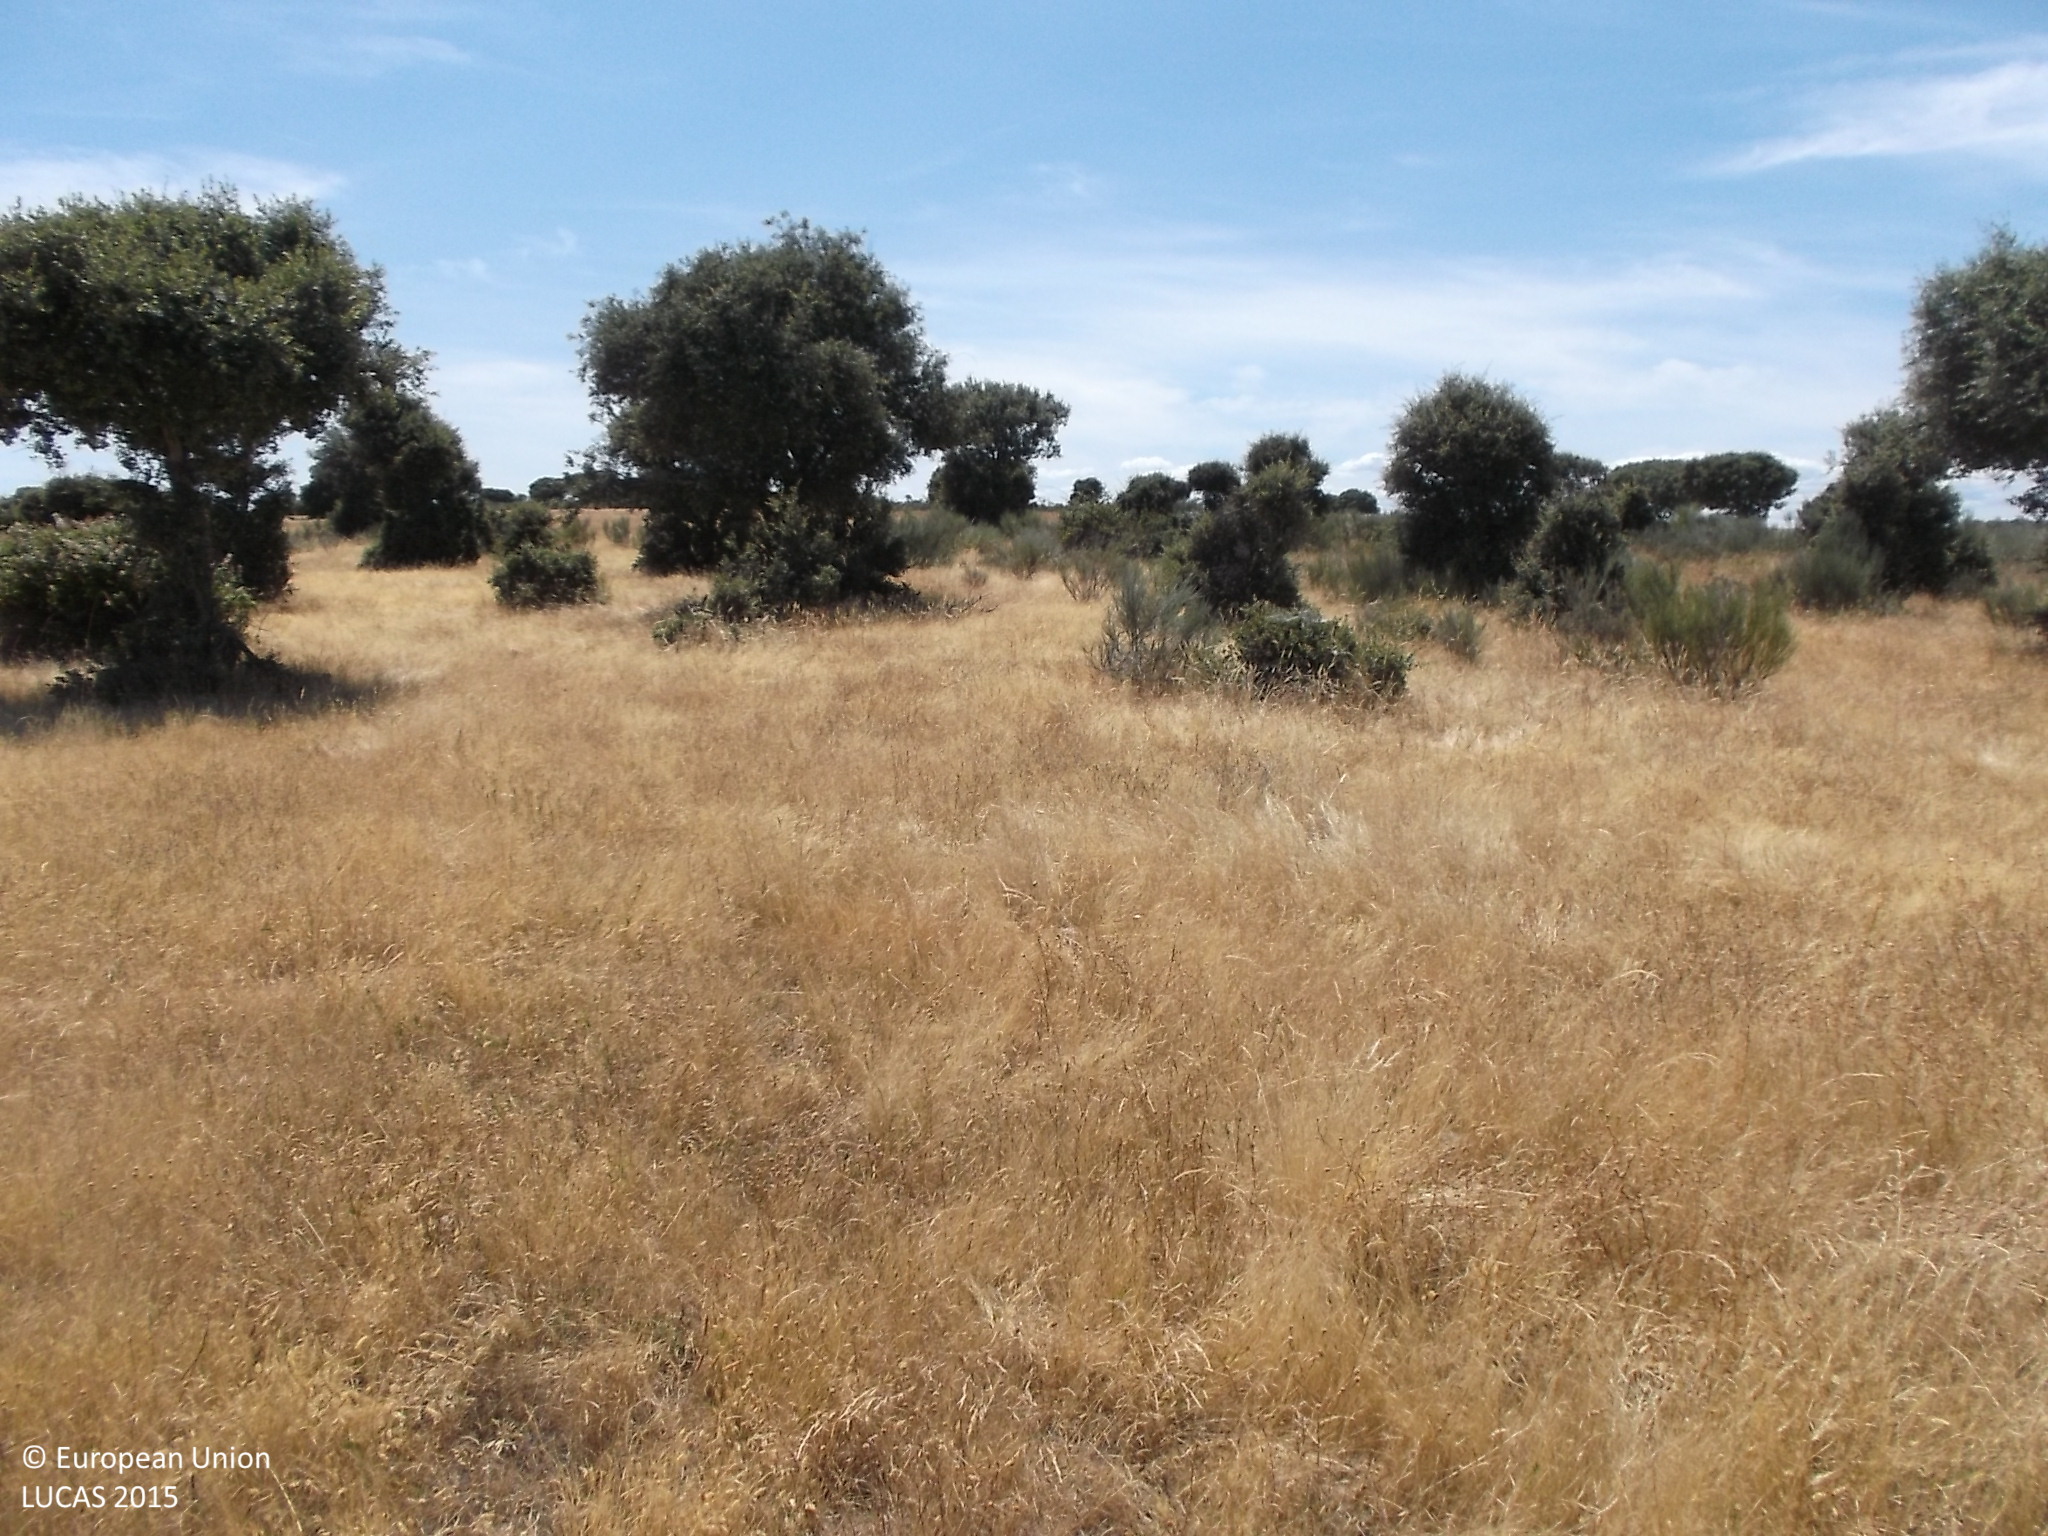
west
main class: Grassland
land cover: Grassland with sparse tree/shrub cover
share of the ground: > 75 %
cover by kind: herbaceous plants 90 %, broadleaved forest trees 5 %, shrubs 5 %
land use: Agriculture (excluding fallow land and kitchen gardens)
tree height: < 5 m
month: July
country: ES
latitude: 40.9635
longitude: -6.7956
